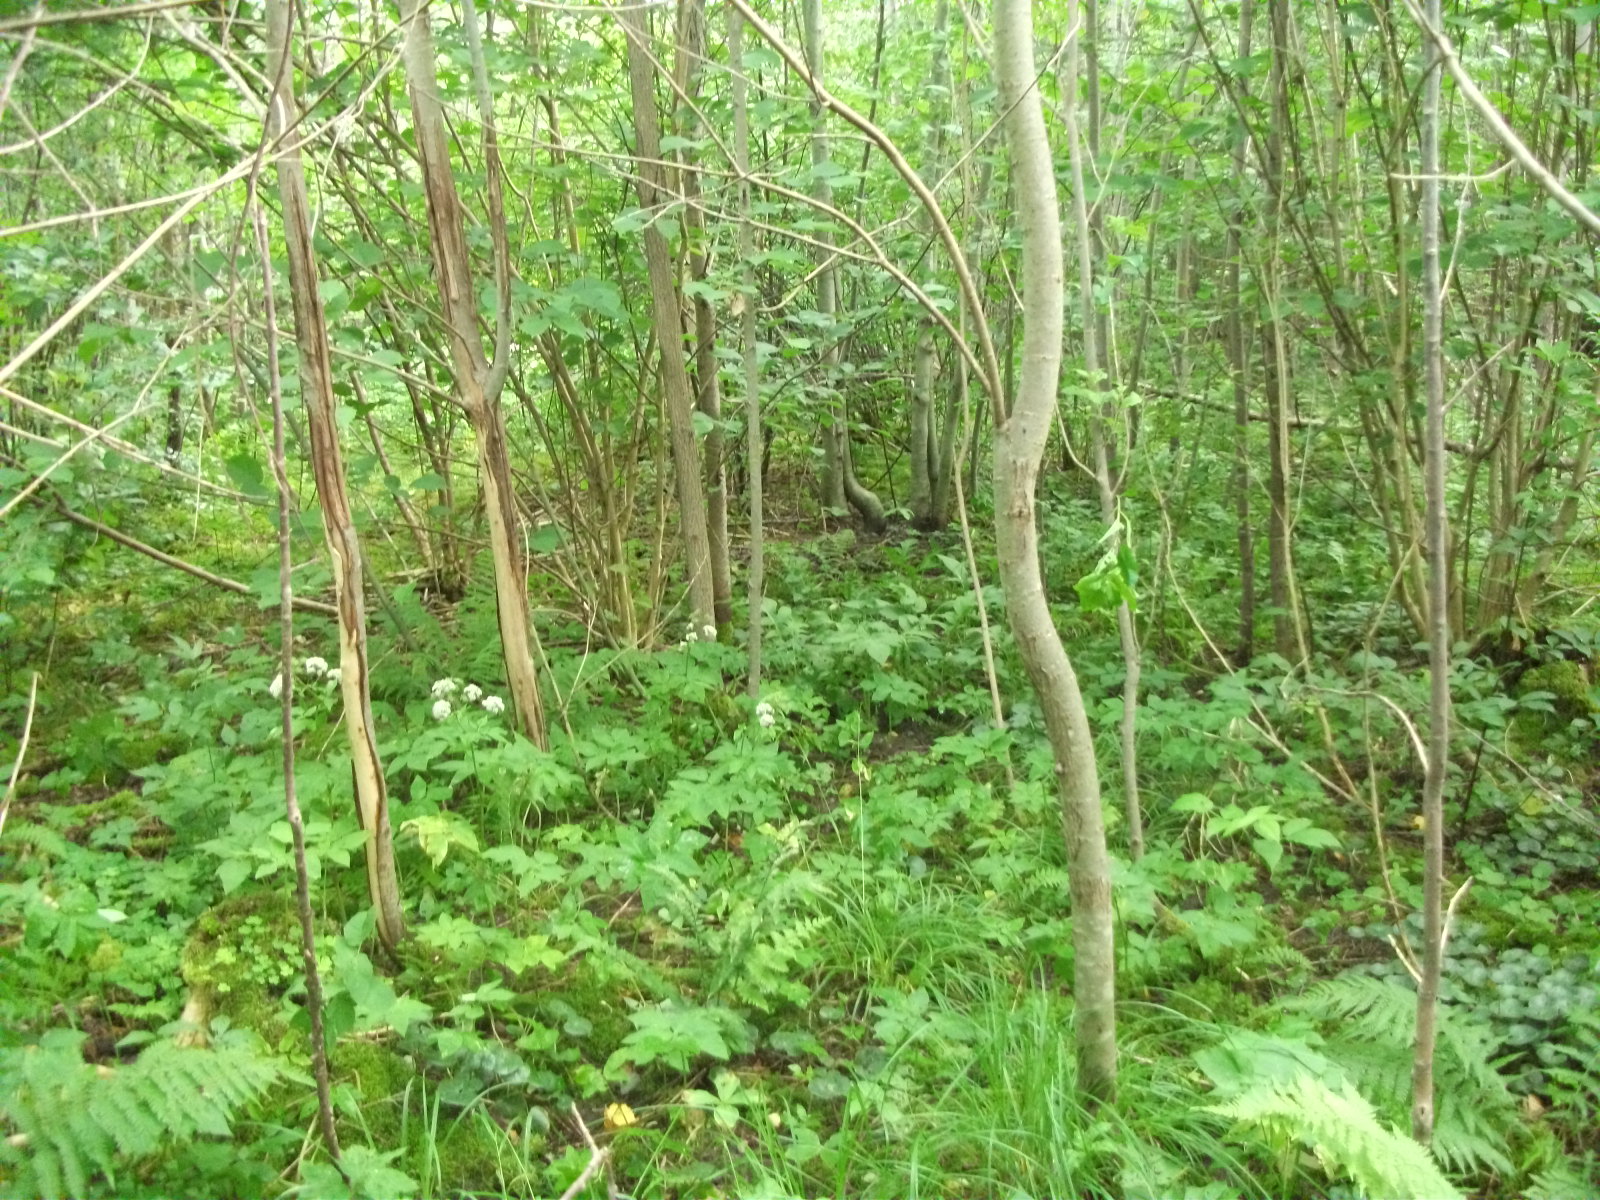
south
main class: Woodland
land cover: Broadleaved woodland
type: non-riverine alder, birch or aspen forest
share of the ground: > 75 %
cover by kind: broadleaved forest trees 90 %, shrubs 5 %, herbaceous plants 5 %
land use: Forestry
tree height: > 5 m
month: July
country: LV
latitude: 57.1219
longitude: 26.4451
